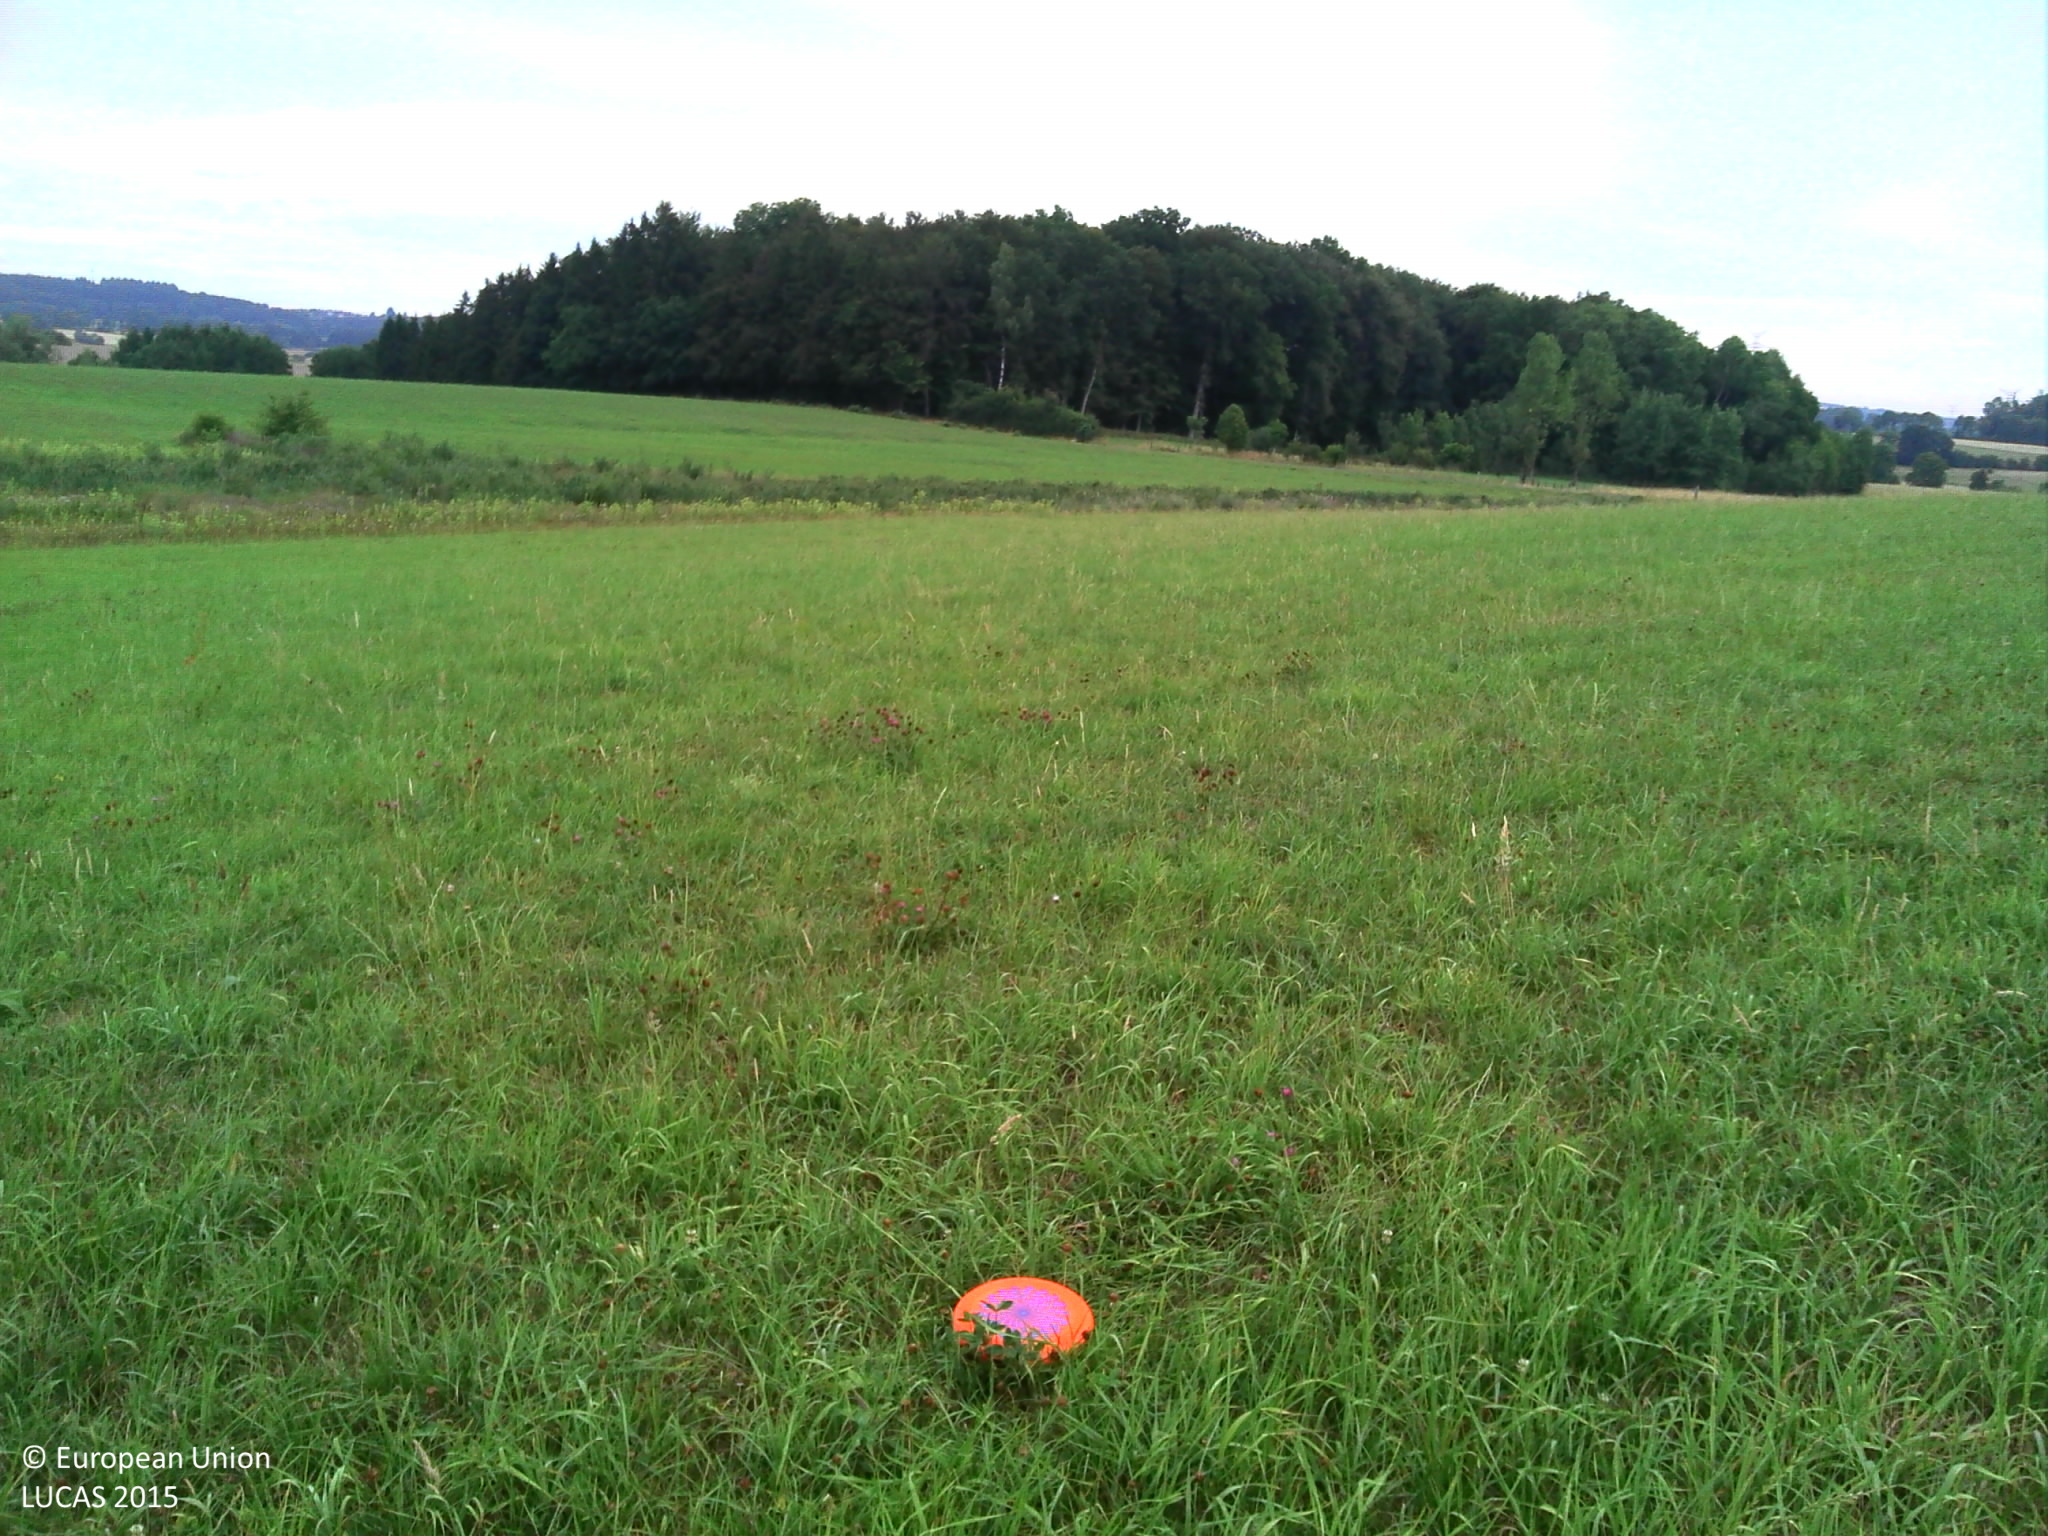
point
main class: Grassland
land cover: Grassland without tree/shrub cover
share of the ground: > 75 %
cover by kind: herbaceous plants 100 %
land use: Agriculture (excluding fallow land and kitchen gardens)
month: July
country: BE
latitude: 49.7265
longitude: 5.7400
